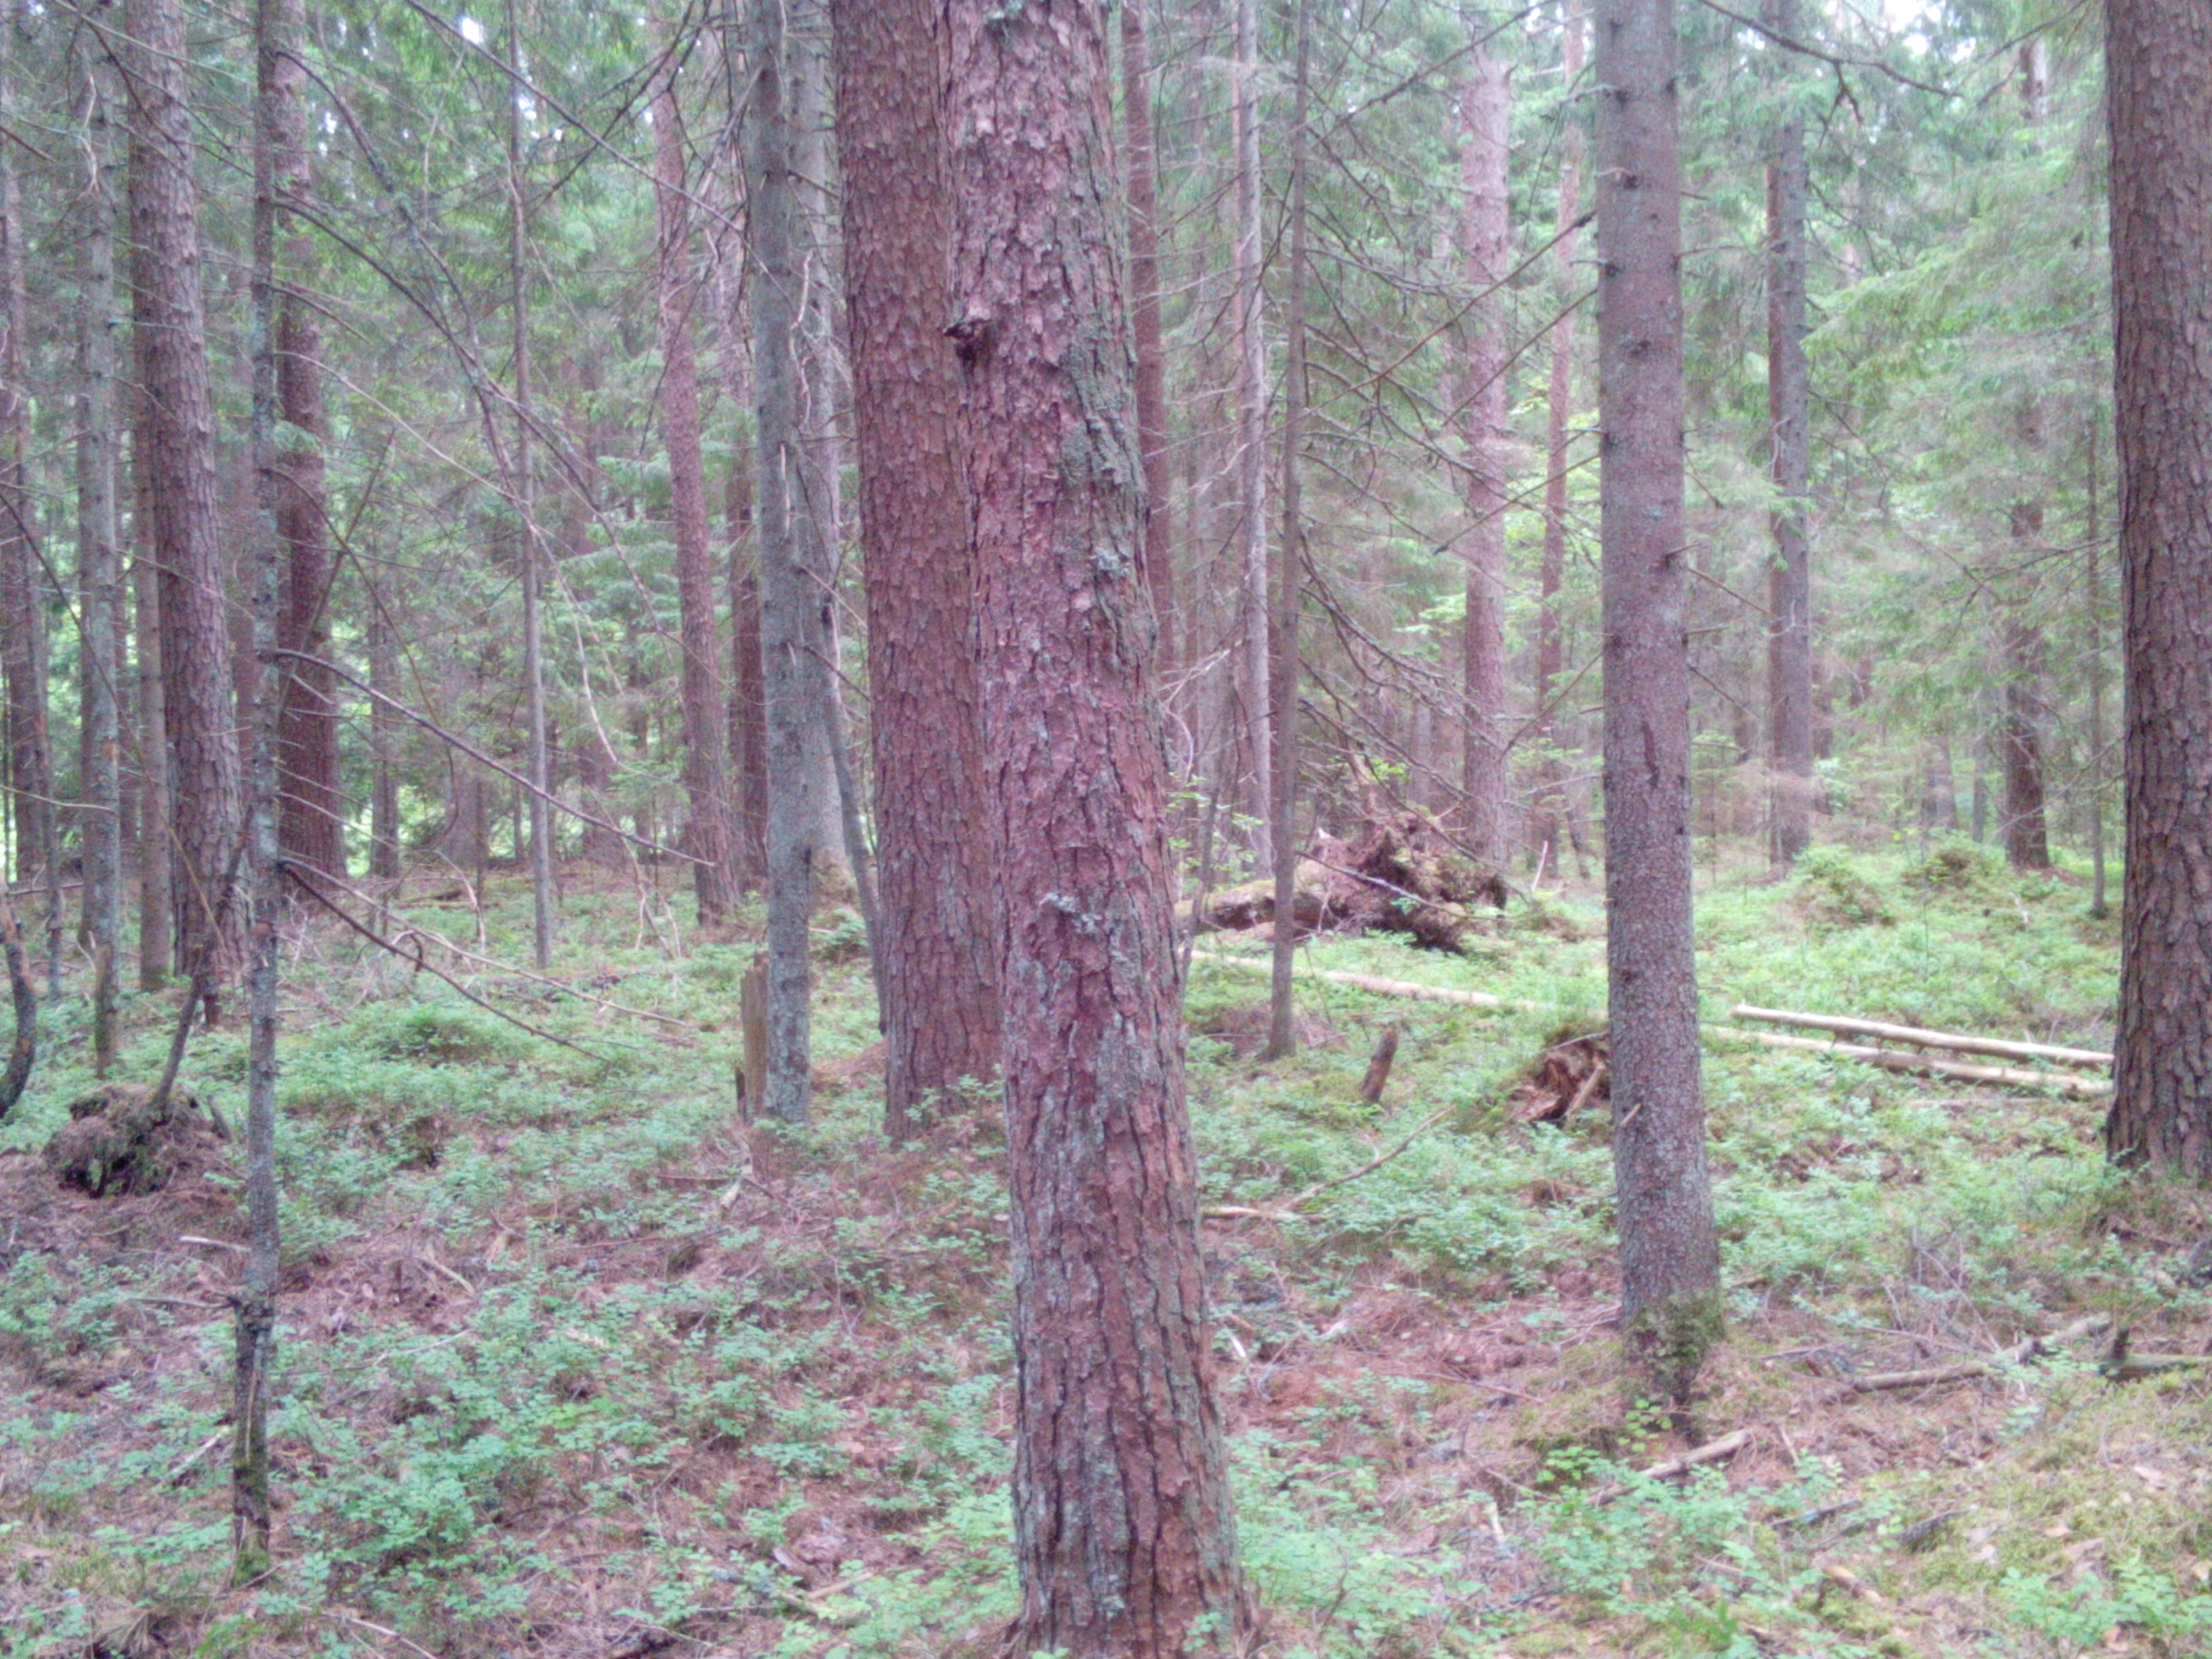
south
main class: Woodland
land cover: Other coniferous woodland
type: hemiboreal forest and nemoral coniferous forest and mixed broadleaved-coniferous forest
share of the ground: > 75 %
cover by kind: coniferous forest trees 85 %, herbaceous plants 10 %, lichens and mosses 5 %
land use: Forestry
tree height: > 5 m
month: June
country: LV
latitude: 56.8180
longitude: 21.4592
